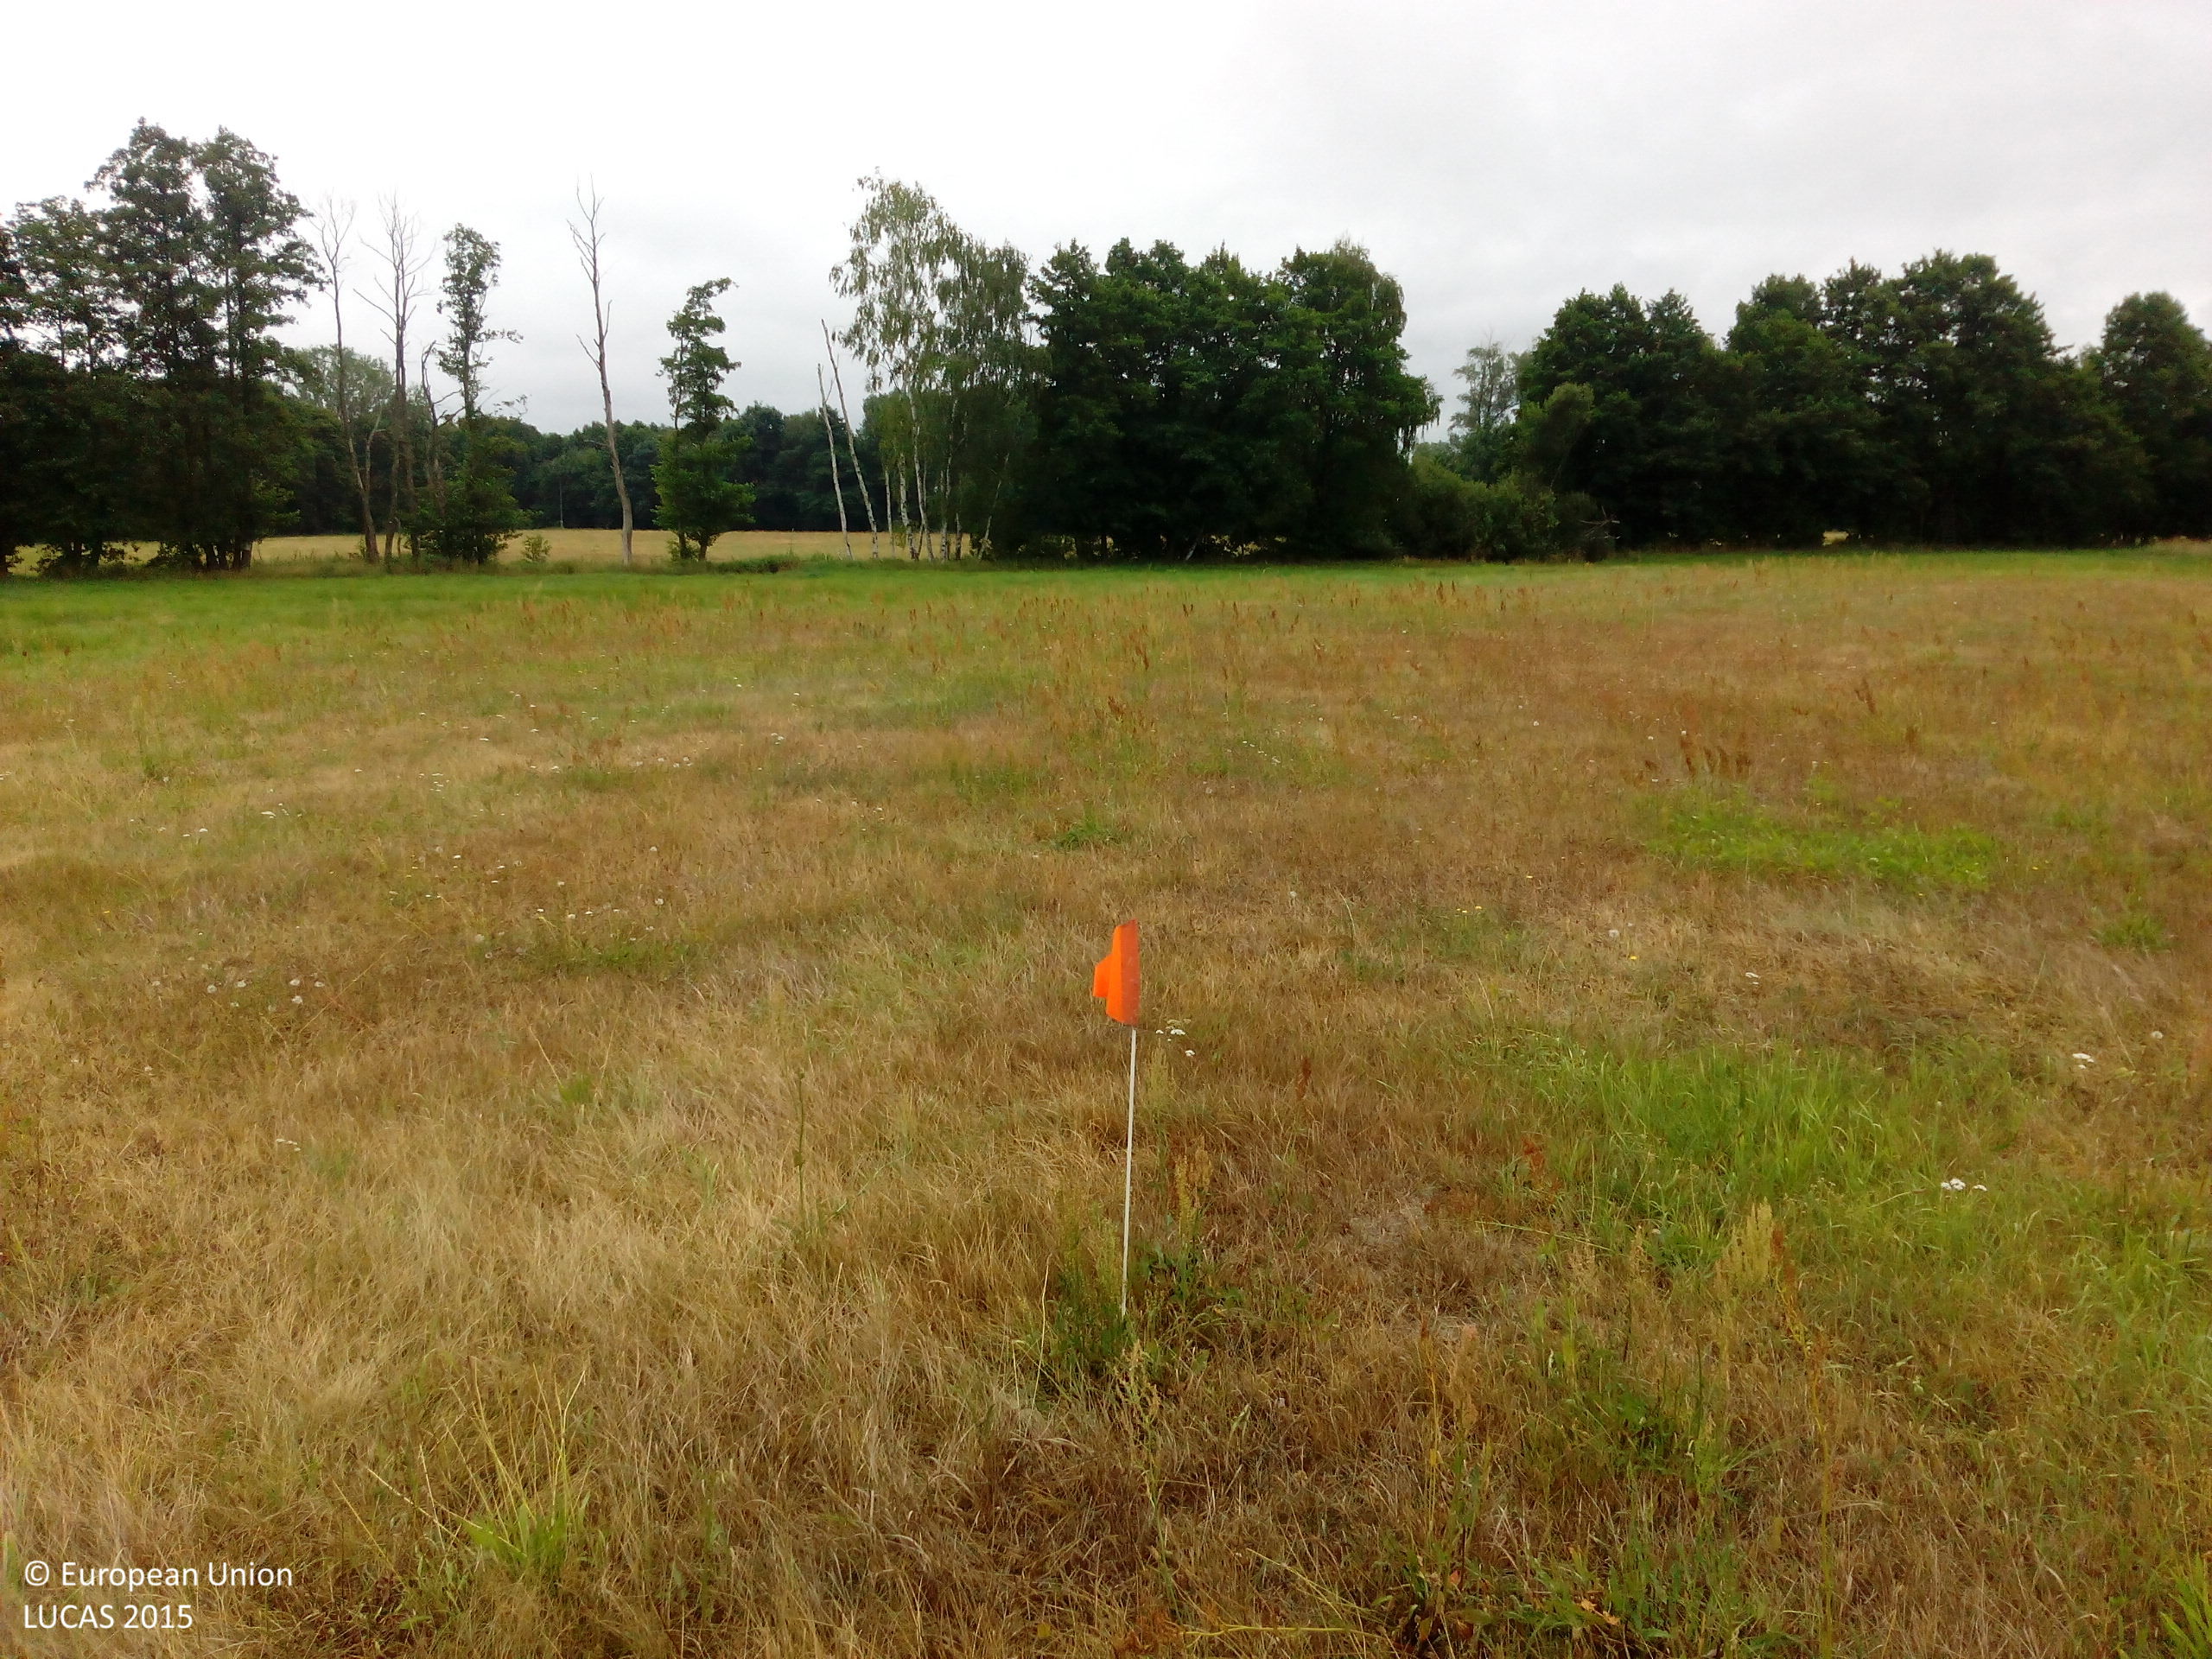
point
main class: Grassland
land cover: Grassland without tree/shrub cover
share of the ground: > 75 %
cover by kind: herbaceous plants 100 %
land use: Agriculture (excluding fallow land and kitchen gardens)
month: August
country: DE
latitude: 51.9112
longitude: 14.0860
